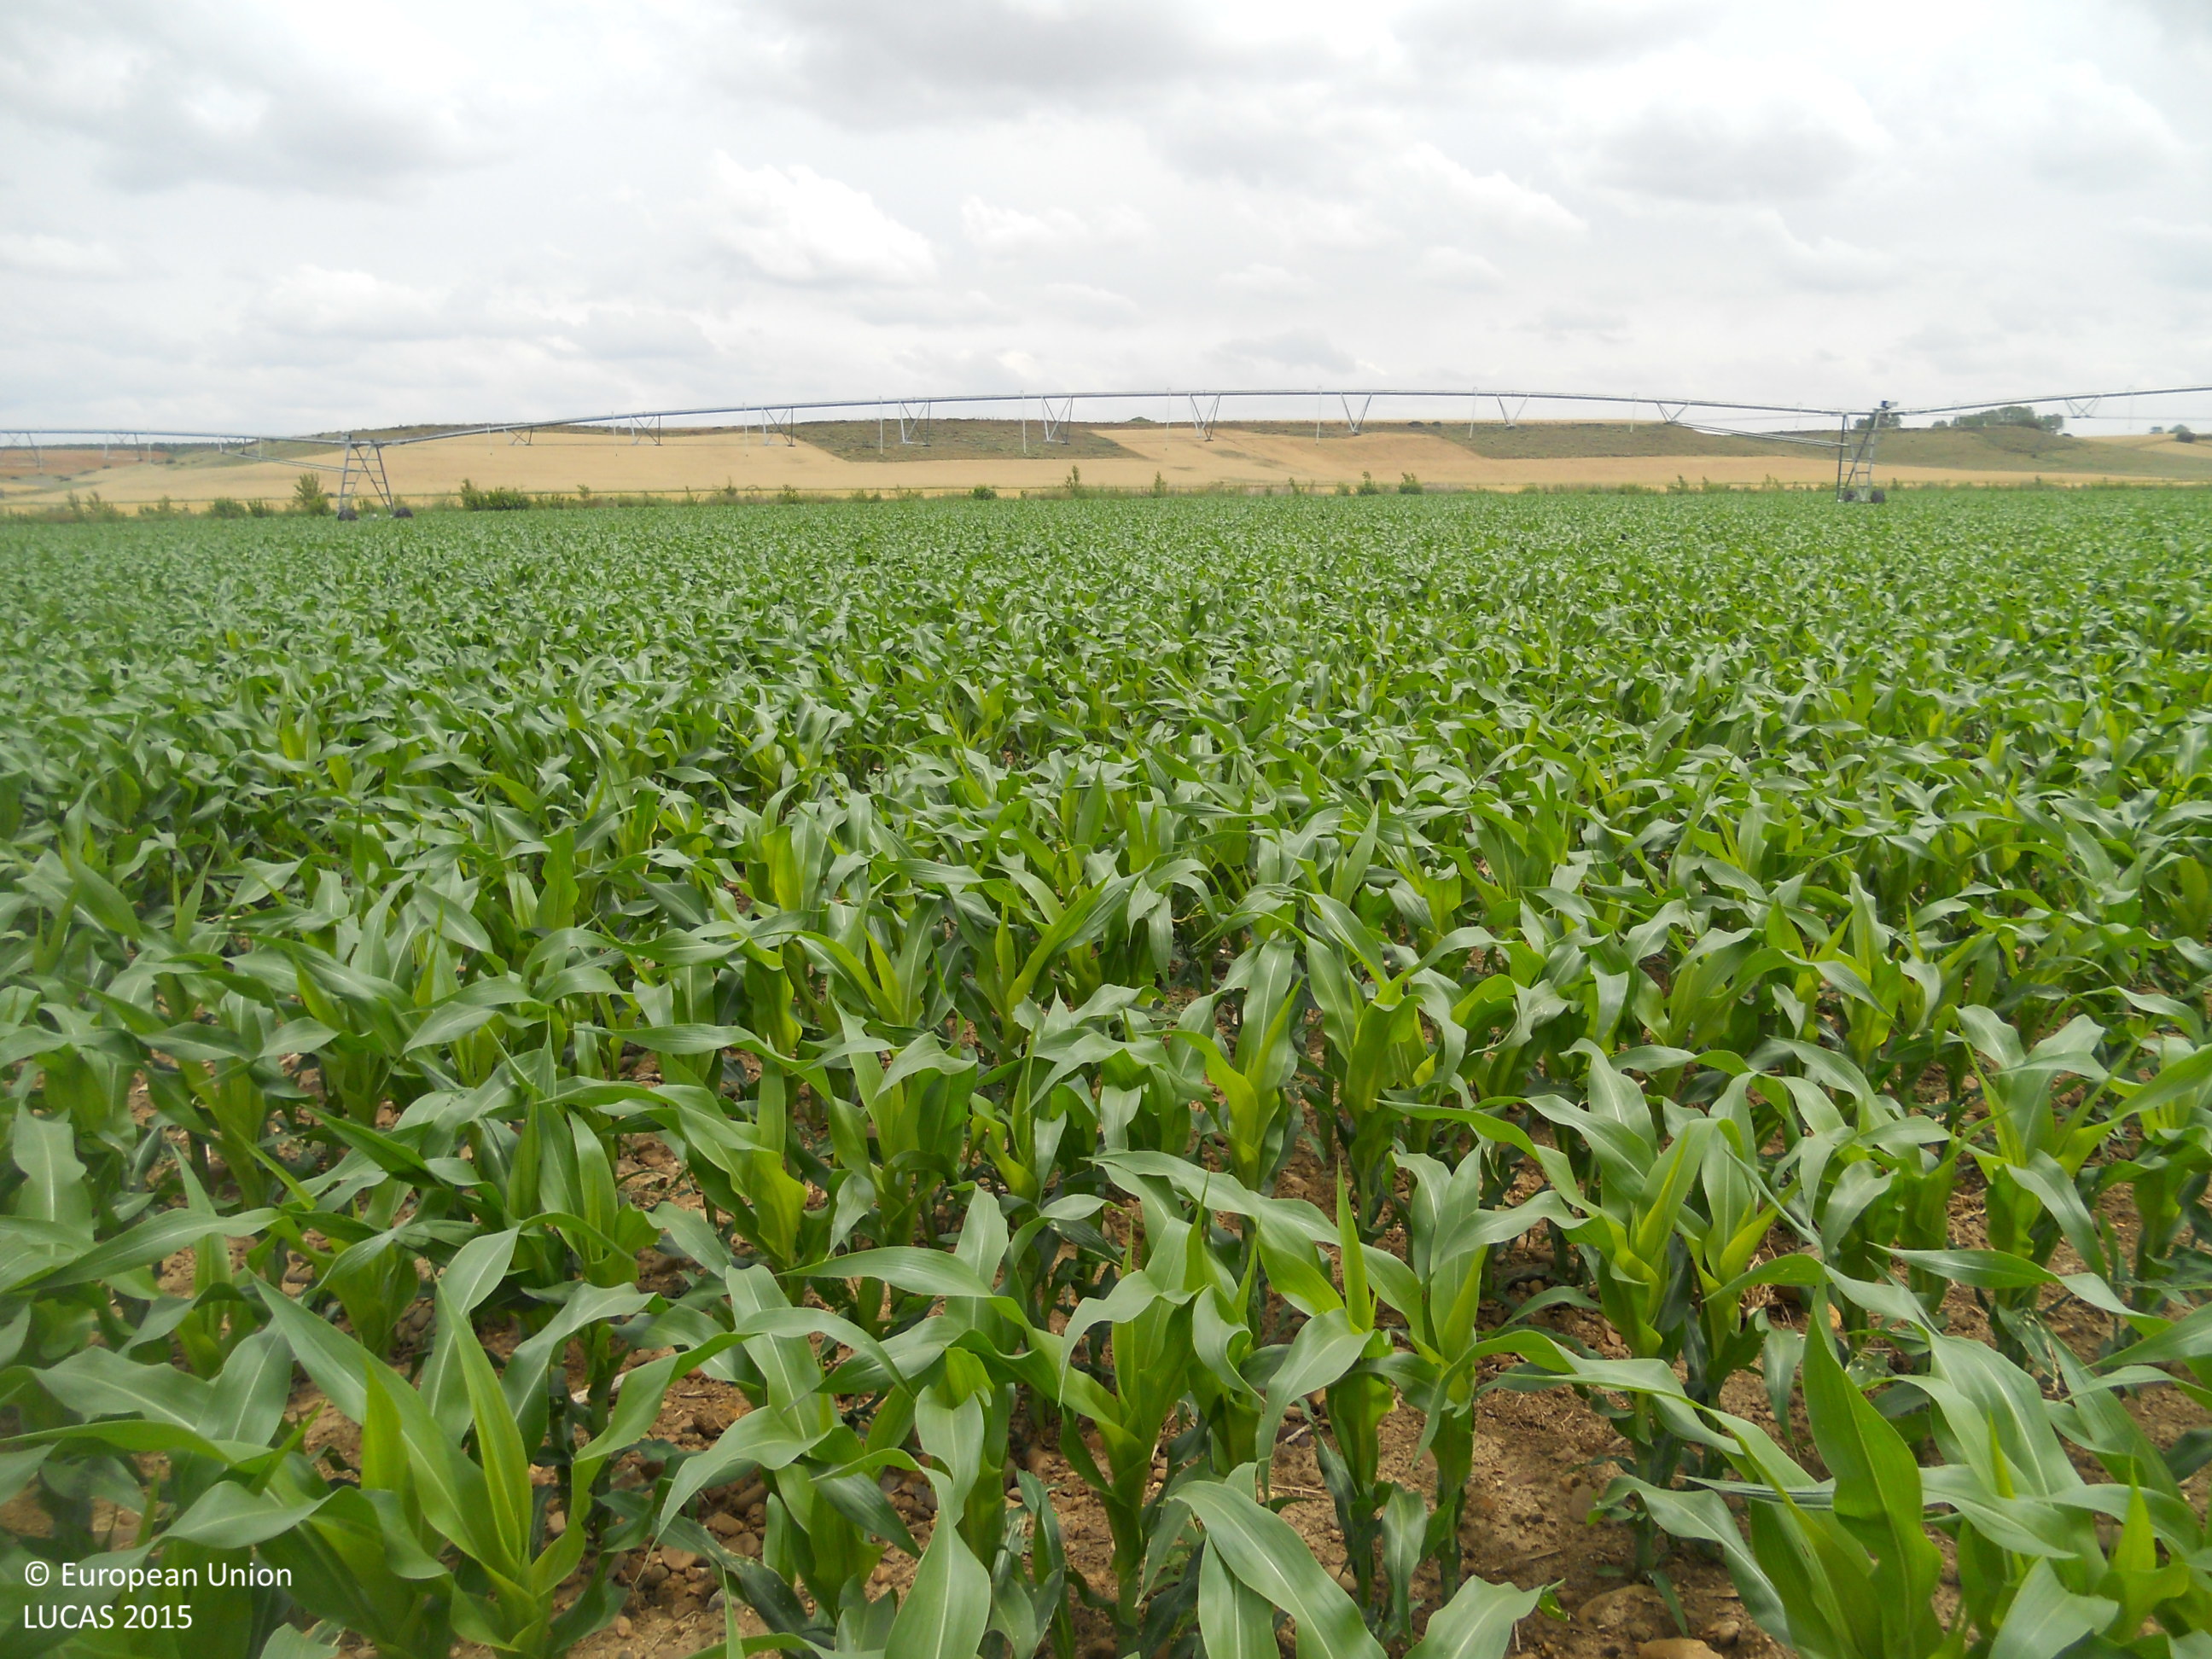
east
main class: Cropland
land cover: Maize
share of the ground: > 75 %
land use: Agriculture (excluding fallow land and kitchen gardens)
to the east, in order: Maize; Grassland without tree/shrub cover; Abandoned hedges; Ditches and canals; Abandoned hedges; Grassland without tree/shrub cover; Grass margins; Ditches and canals; Grass margins; Common wheat
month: June
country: ES
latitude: 42.2969
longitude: -5.2610
